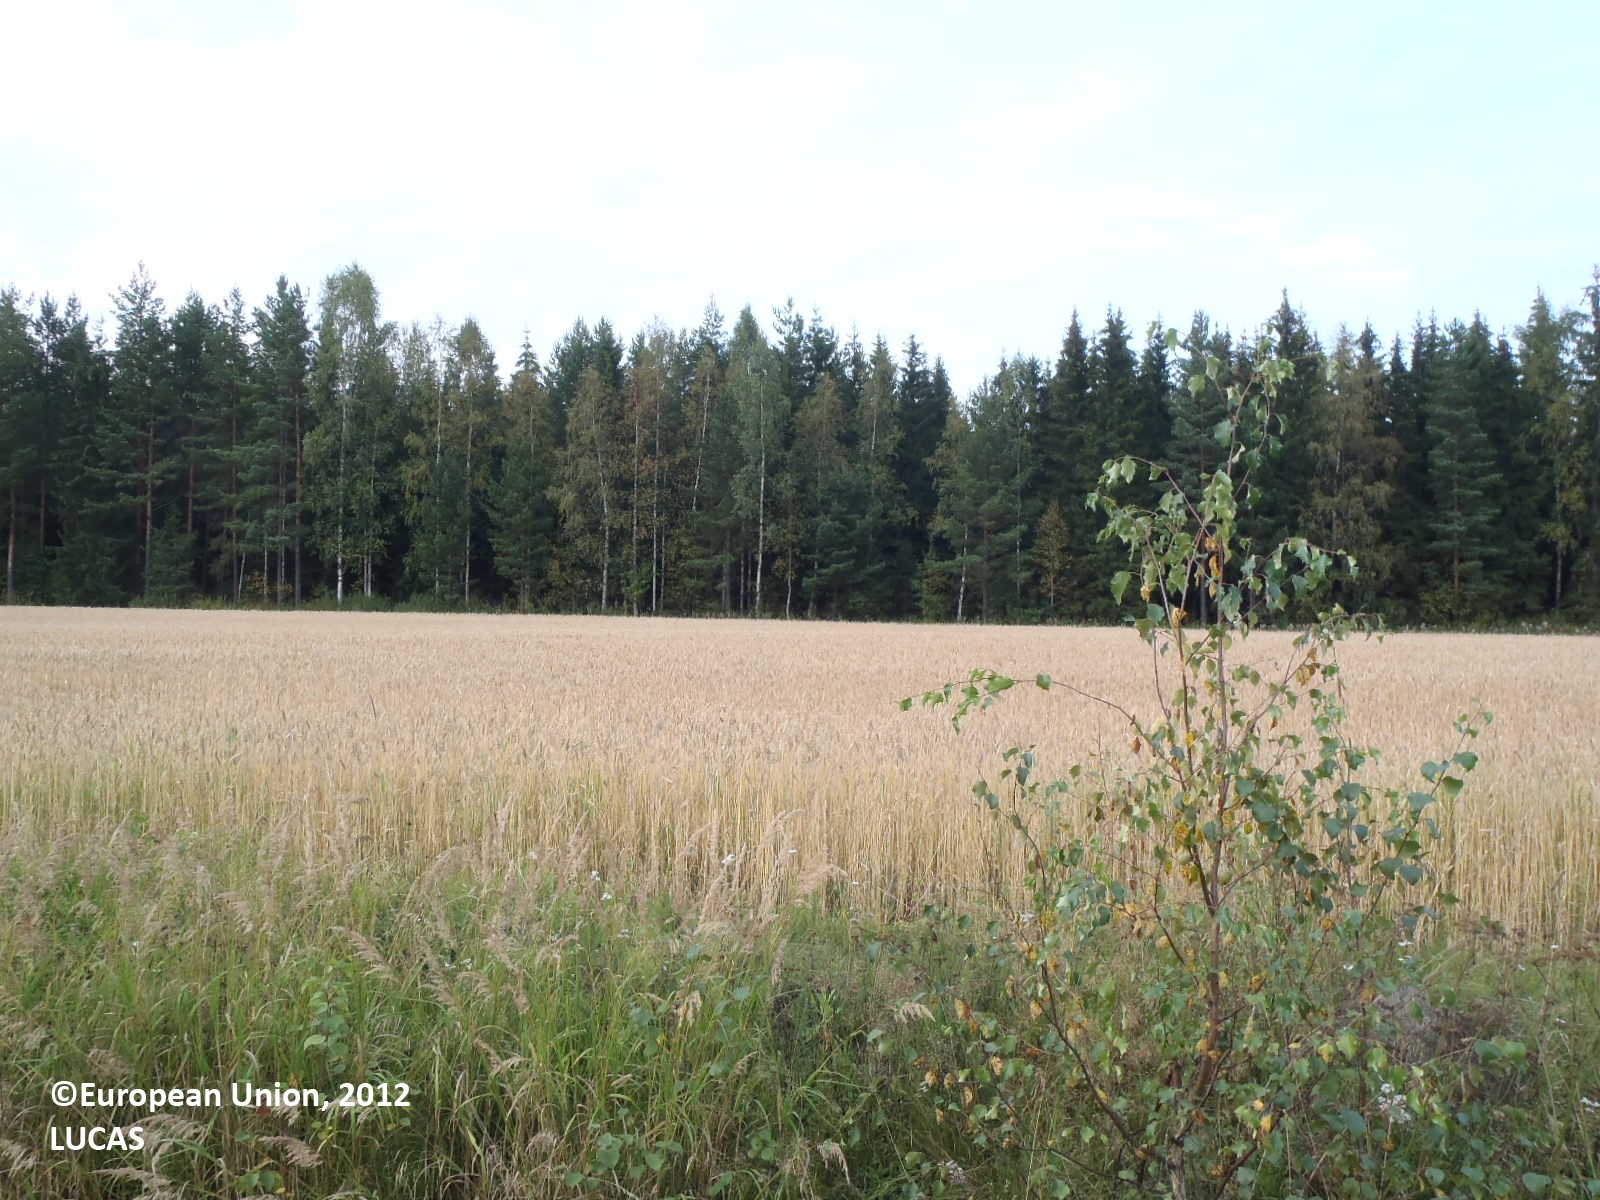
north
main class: Cropland
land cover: Rape and turnip rape
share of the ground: > 75 %
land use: Agriculture (excluding fallow land and kitchen gardens)
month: August
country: FI
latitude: 60.9318
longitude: 22.5598
